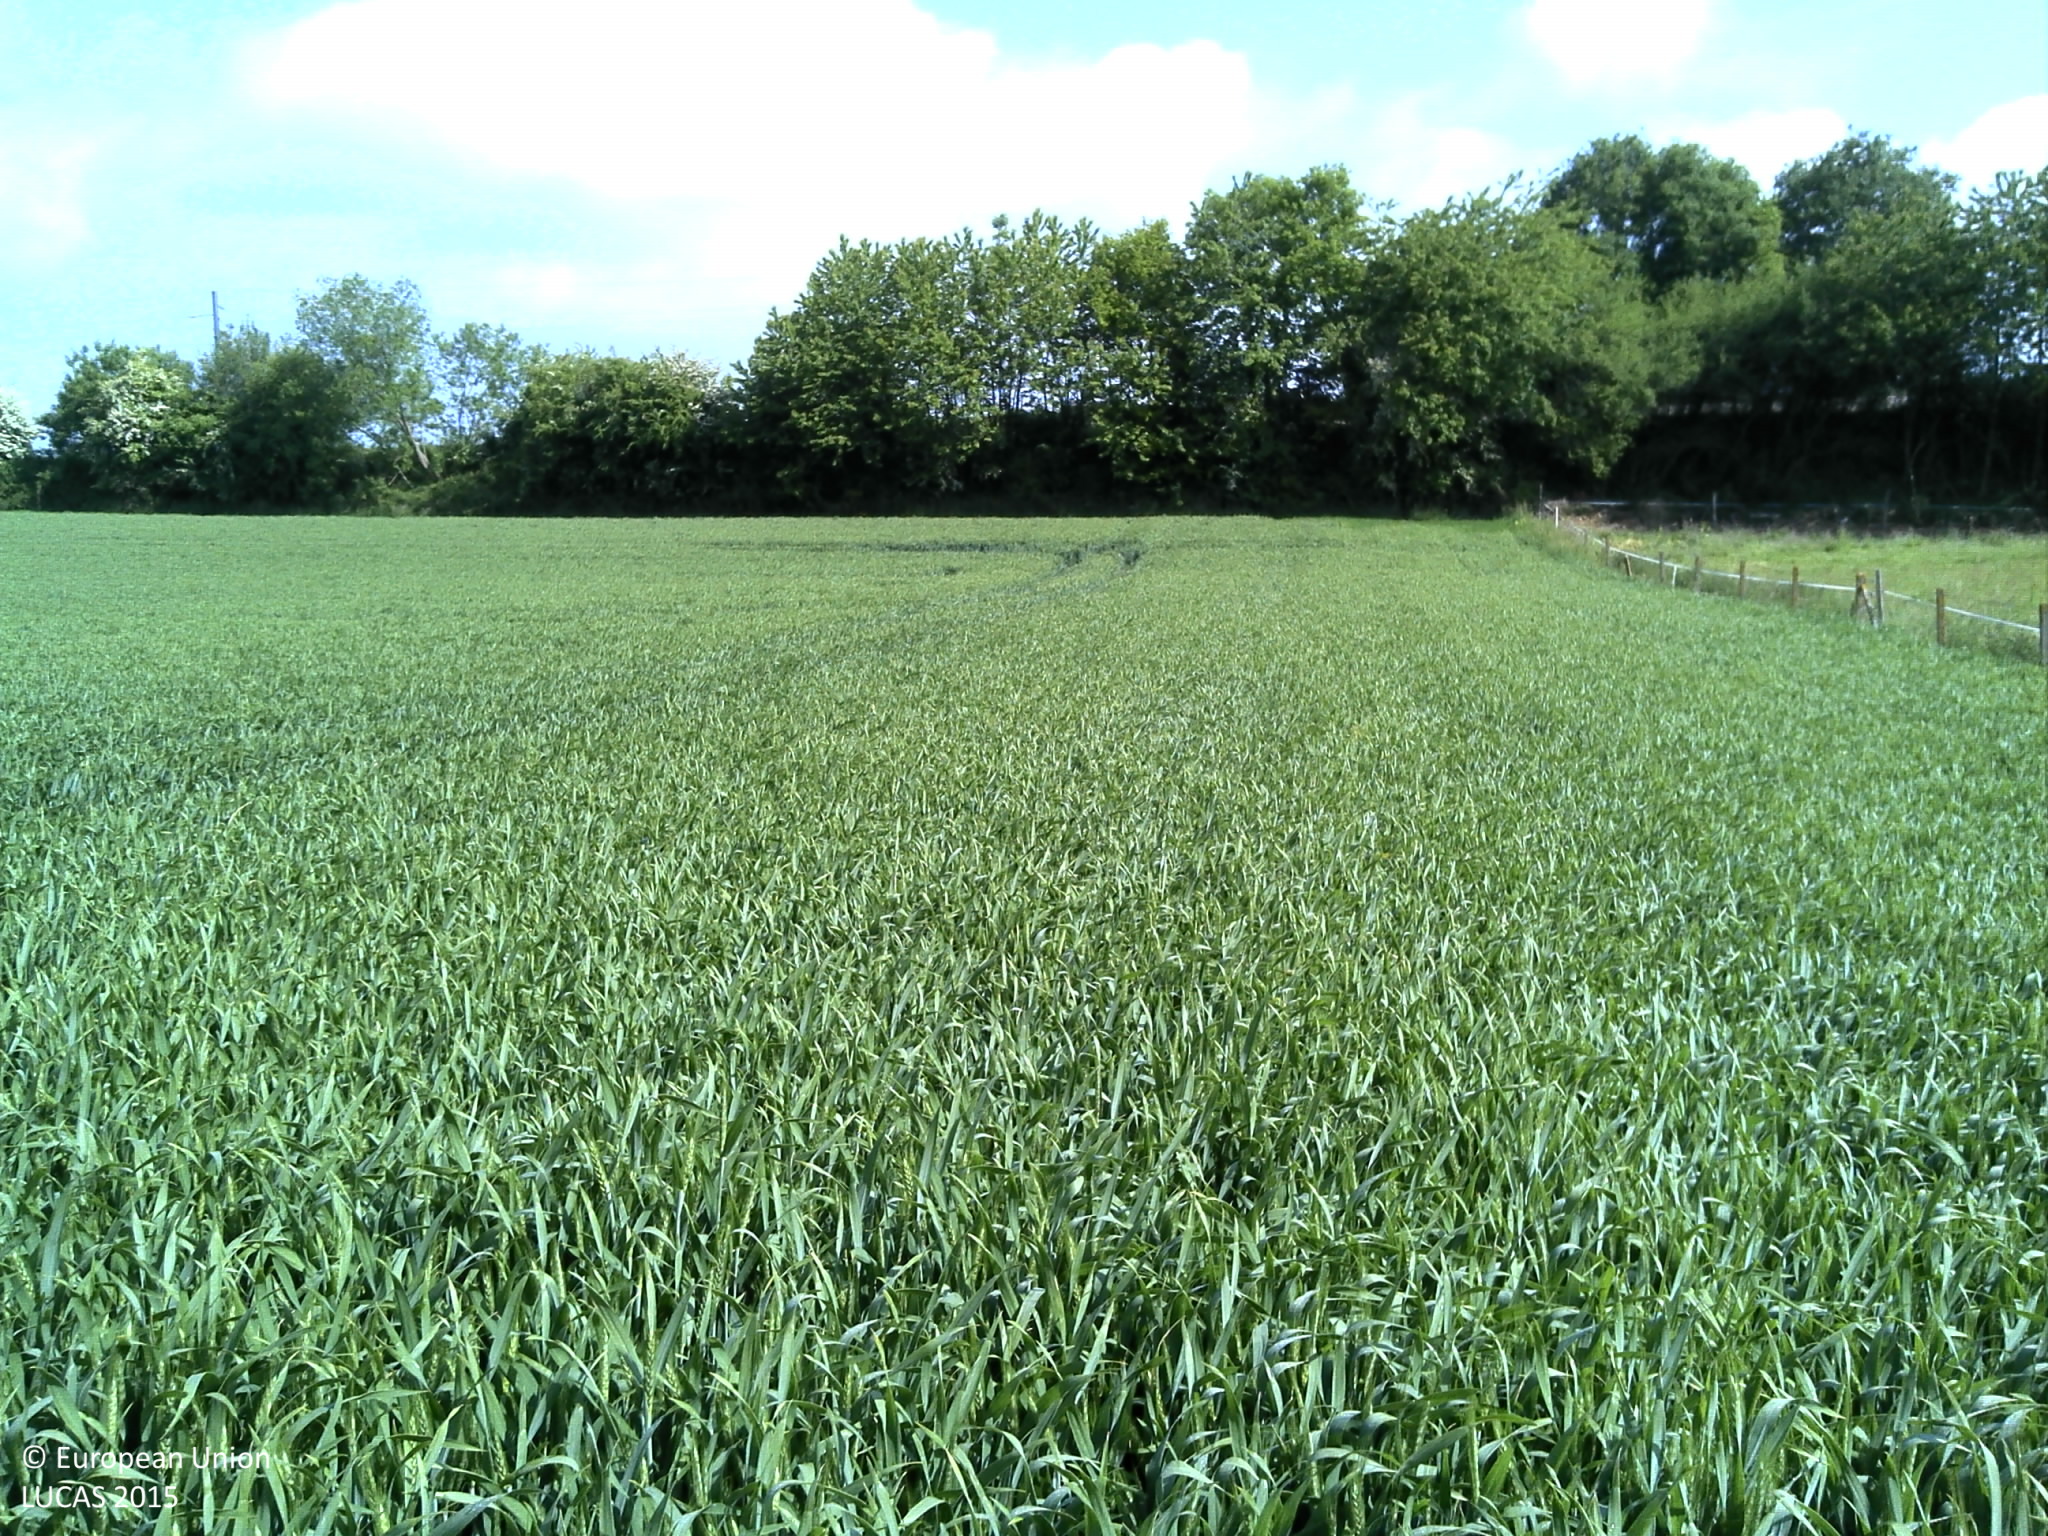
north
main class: Cropland
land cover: Durum wheat
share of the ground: > 75 %
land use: Agriculture (excluding fallow land and kitchen gardens)
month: May
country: FR
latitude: 49.6437
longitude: 0.9617
